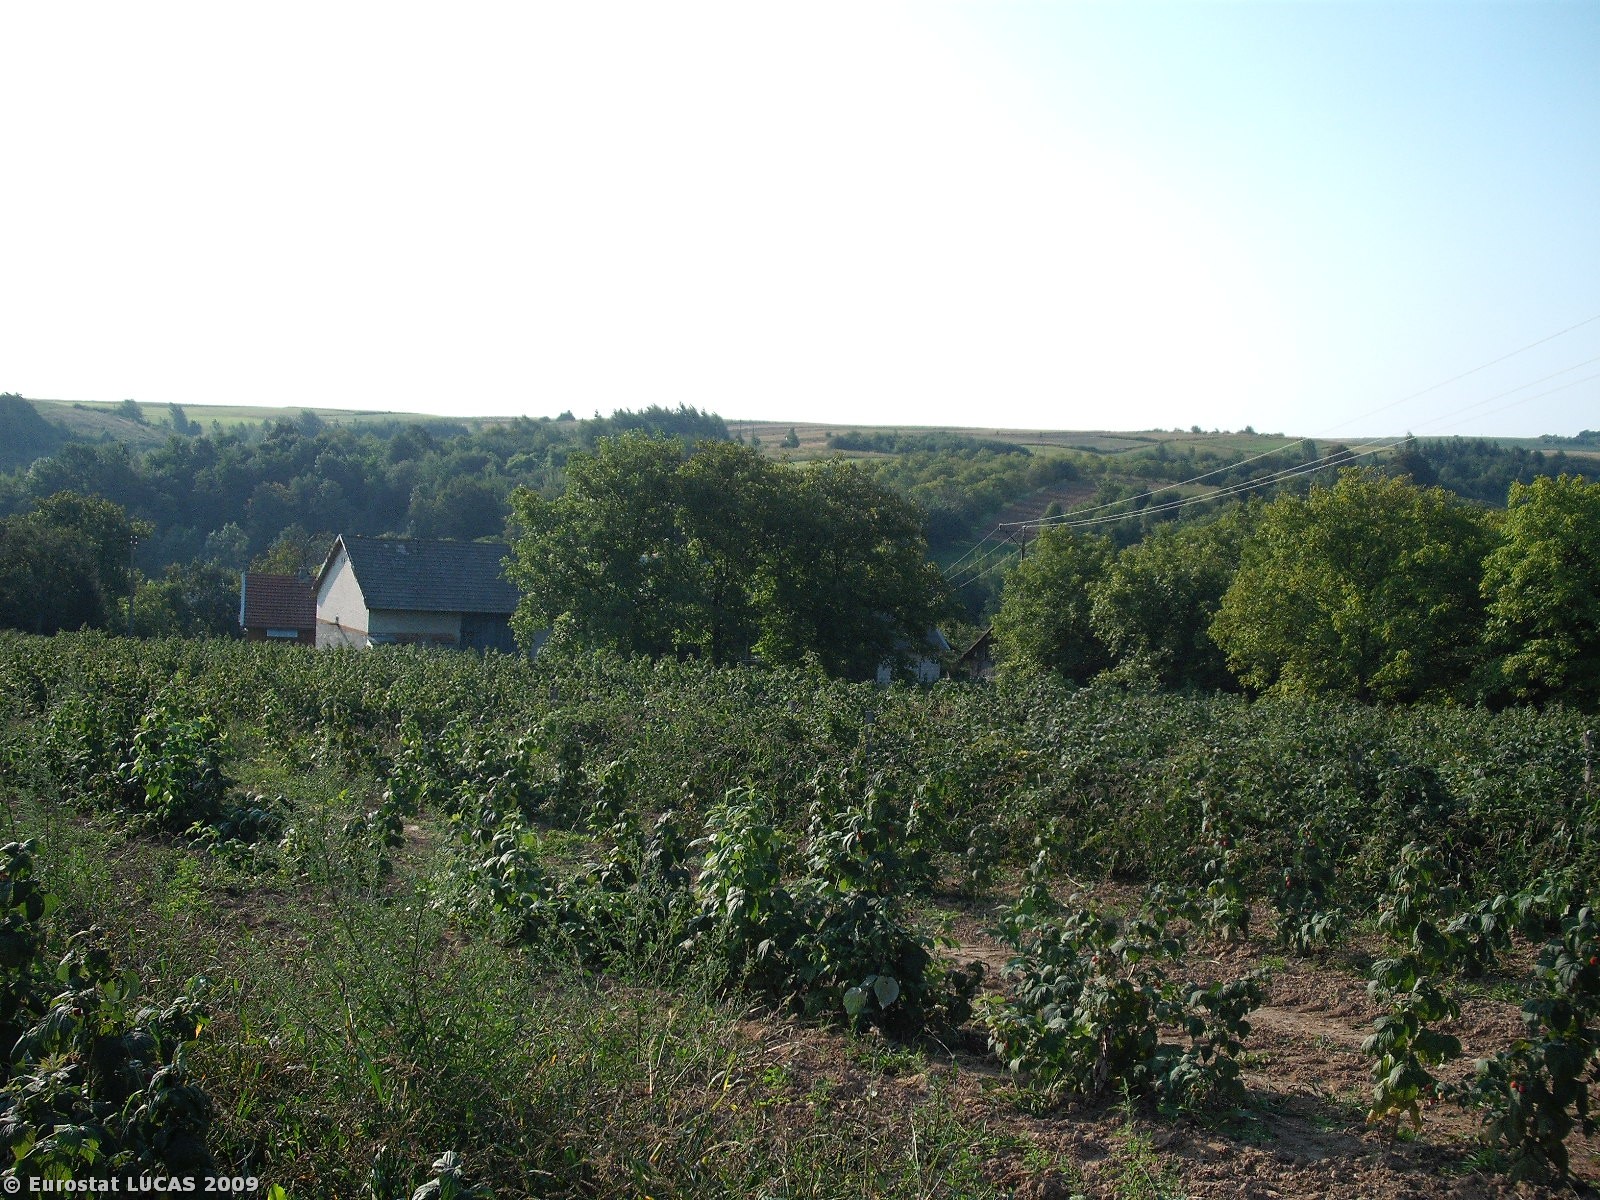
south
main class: Cropland
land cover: Other fruit trees and berries
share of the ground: 50 - 75 %
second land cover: Grassland with sparse tree/shrub cover
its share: > 75 %
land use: Agriculture (excluding fallow land and kitchen gardens)
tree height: < 5 m
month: August
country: PL
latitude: 49.9207
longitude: 22.4180
